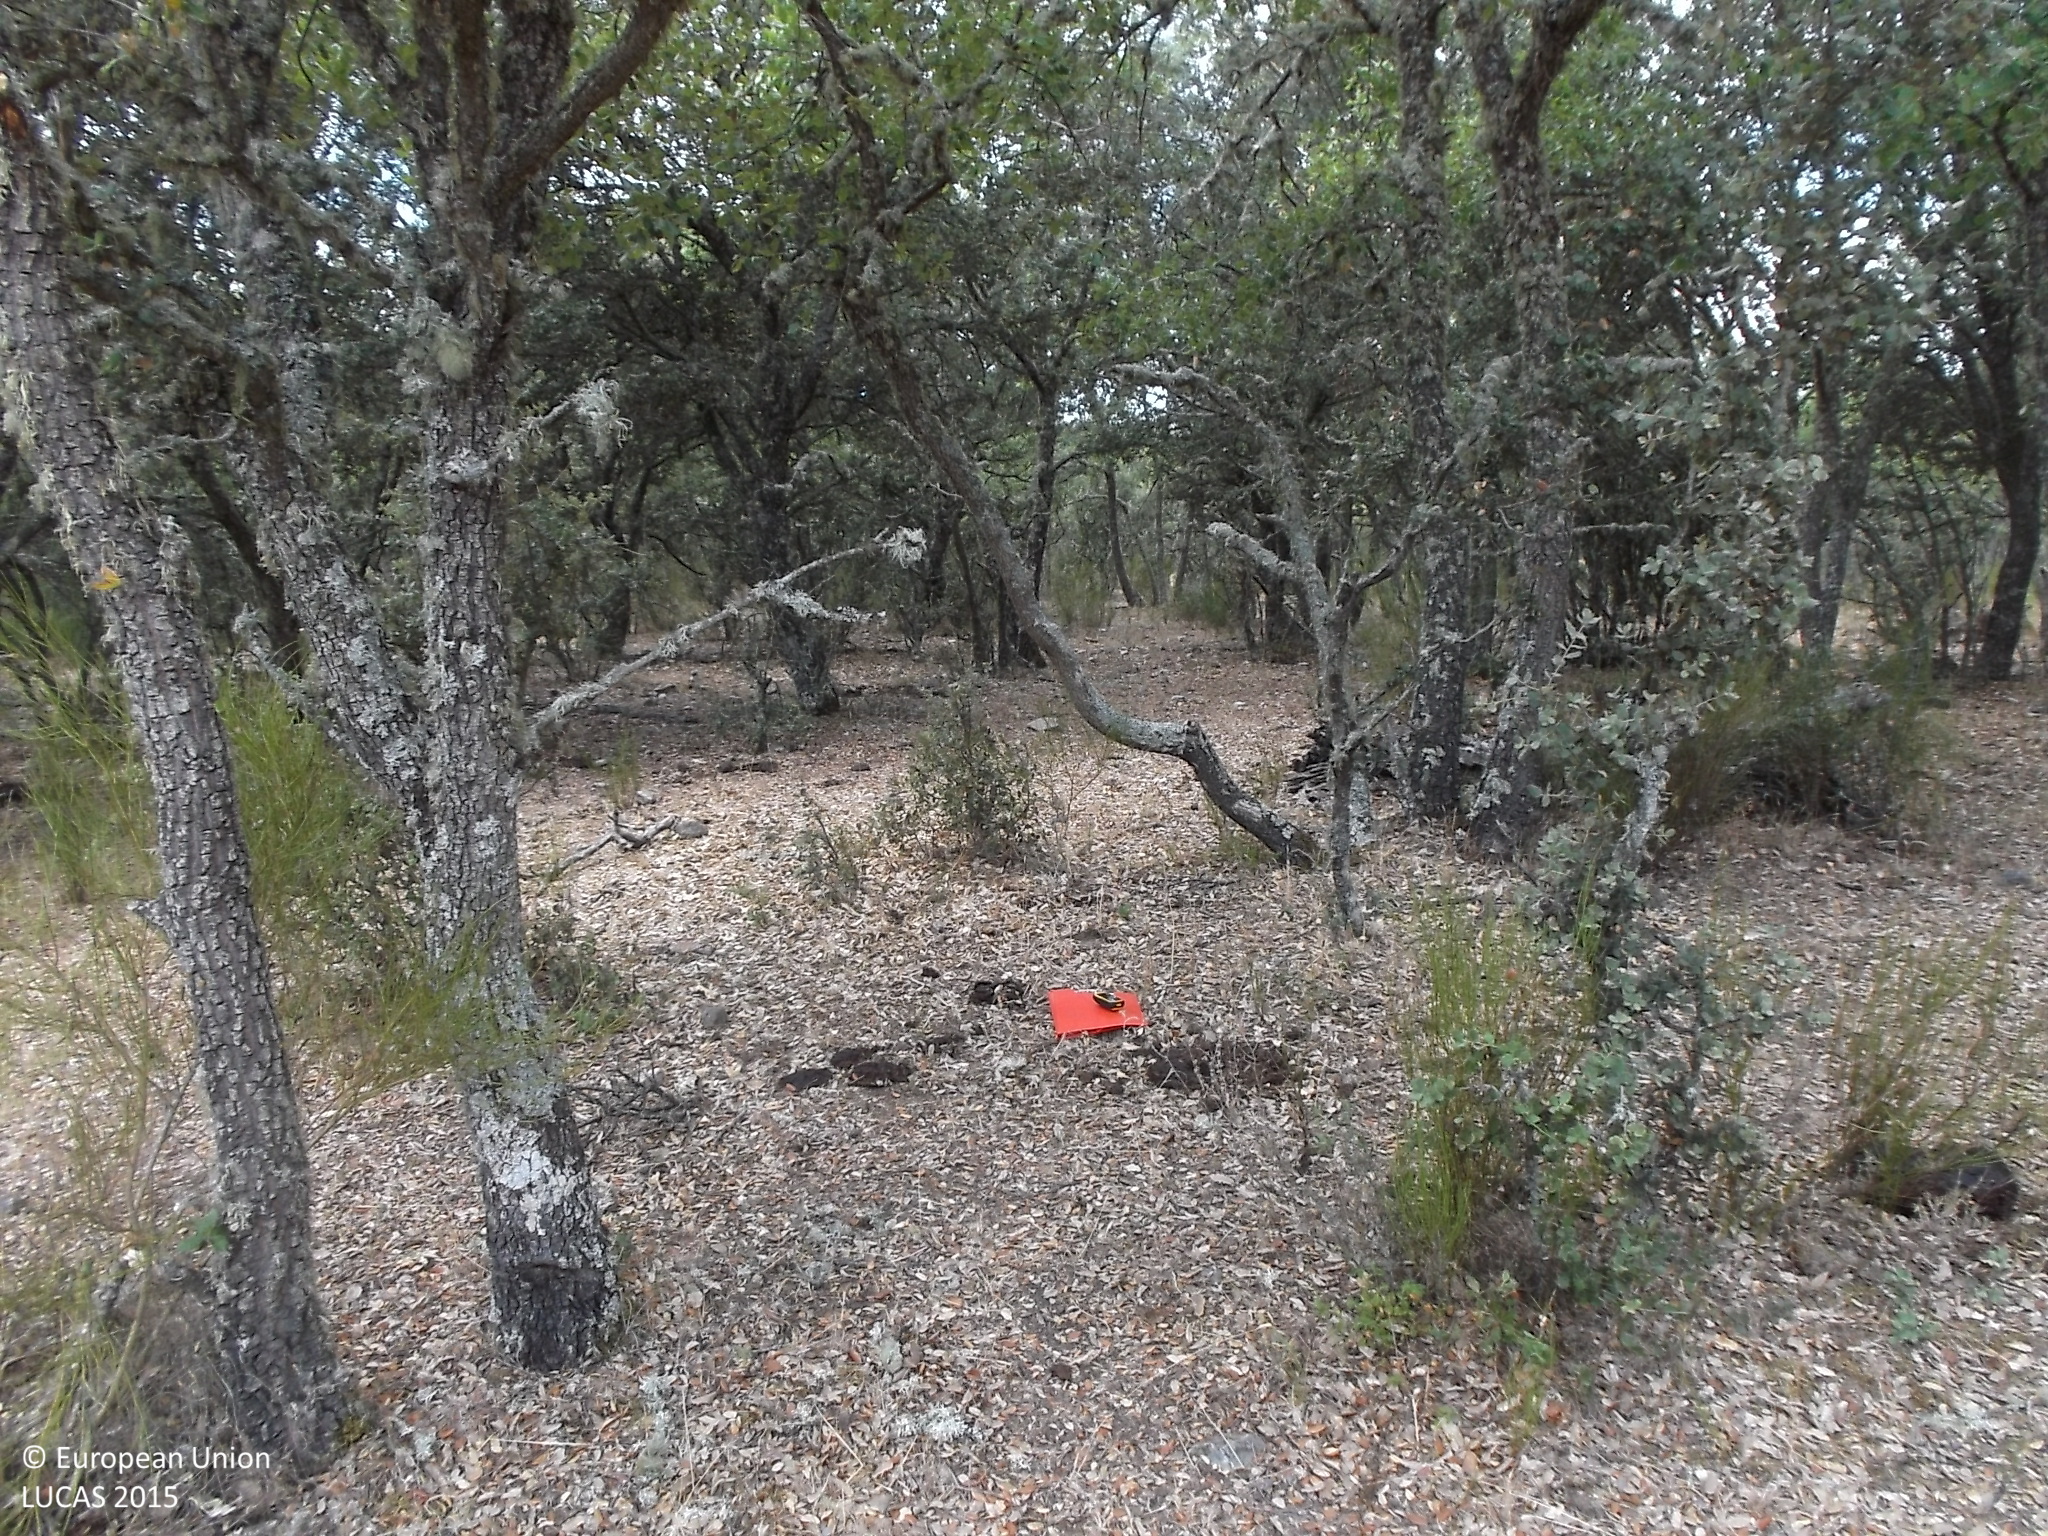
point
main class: Woodland
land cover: Broadleaved woodland
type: broadleaved evergreen forest
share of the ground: 25 - 50 %
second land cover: Shrubland without tree cover
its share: 25 - 50 %
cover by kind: broadleaved forest trees 40 %, shrubs 40 %, herbaceous plants 20 %
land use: Forestry
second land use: Agriculture (excluding fallow land and kitchen gardens)
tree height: < 5 m
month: July
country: ES
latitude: 40.9034
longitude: -6.3905
